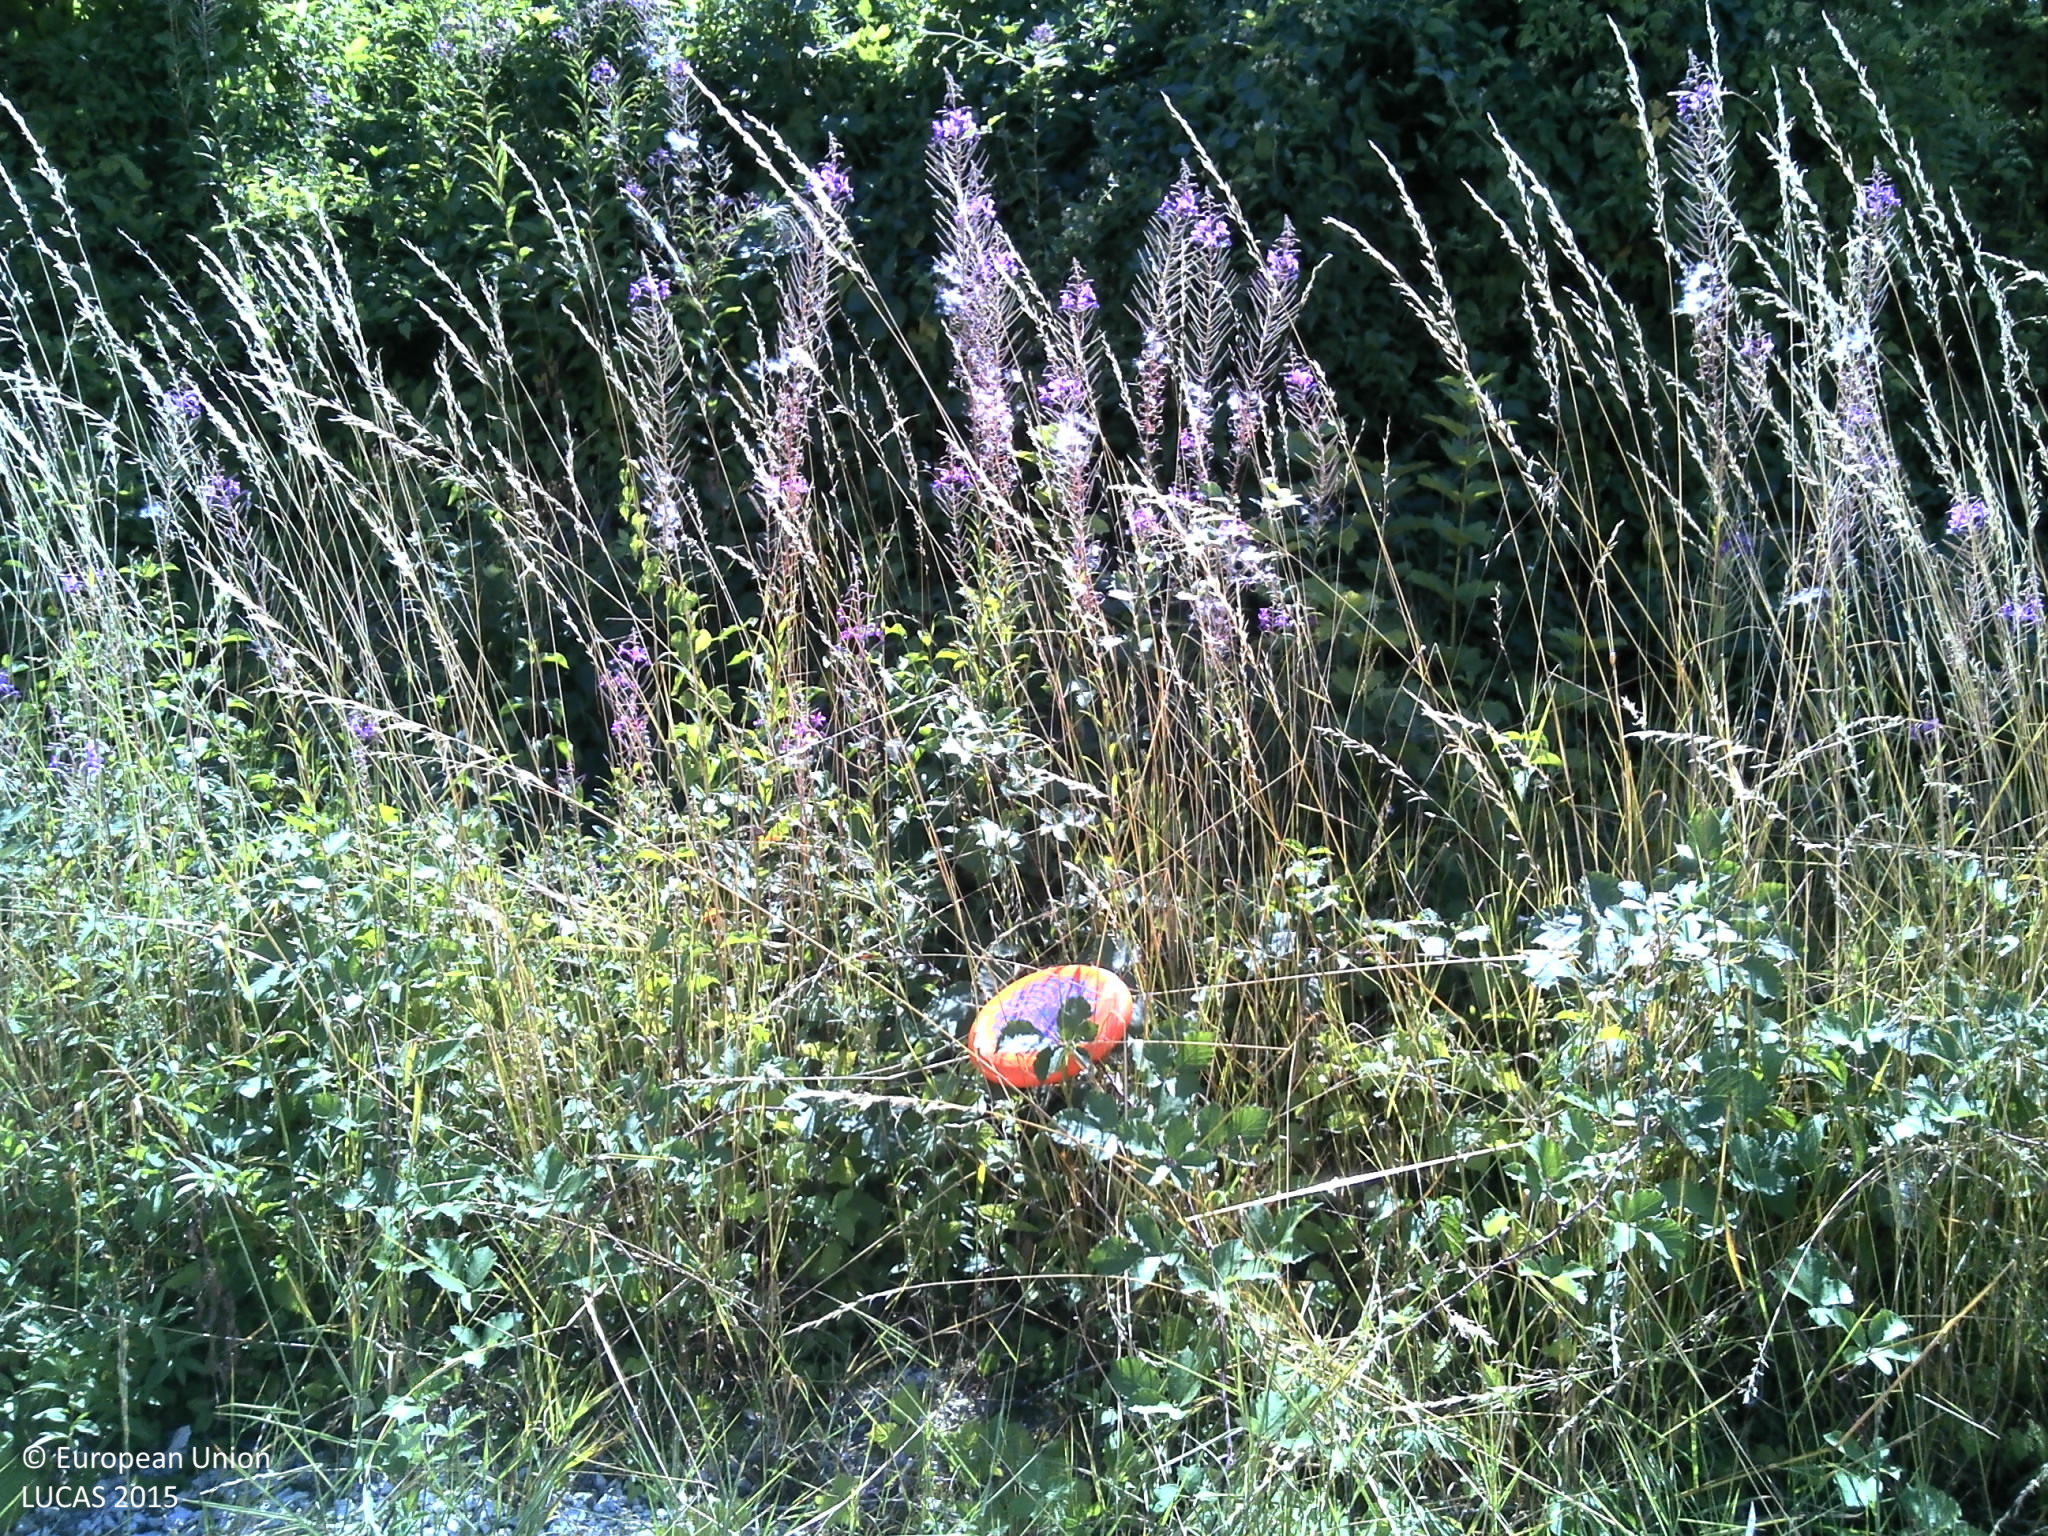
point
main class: Cropland
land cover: Rape and turnip rape
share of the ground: > 75 %
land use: Agriculture (excluding fallow land and kitchen gardens)
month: August
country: FR
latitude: 49.2490
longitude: 4.6805
